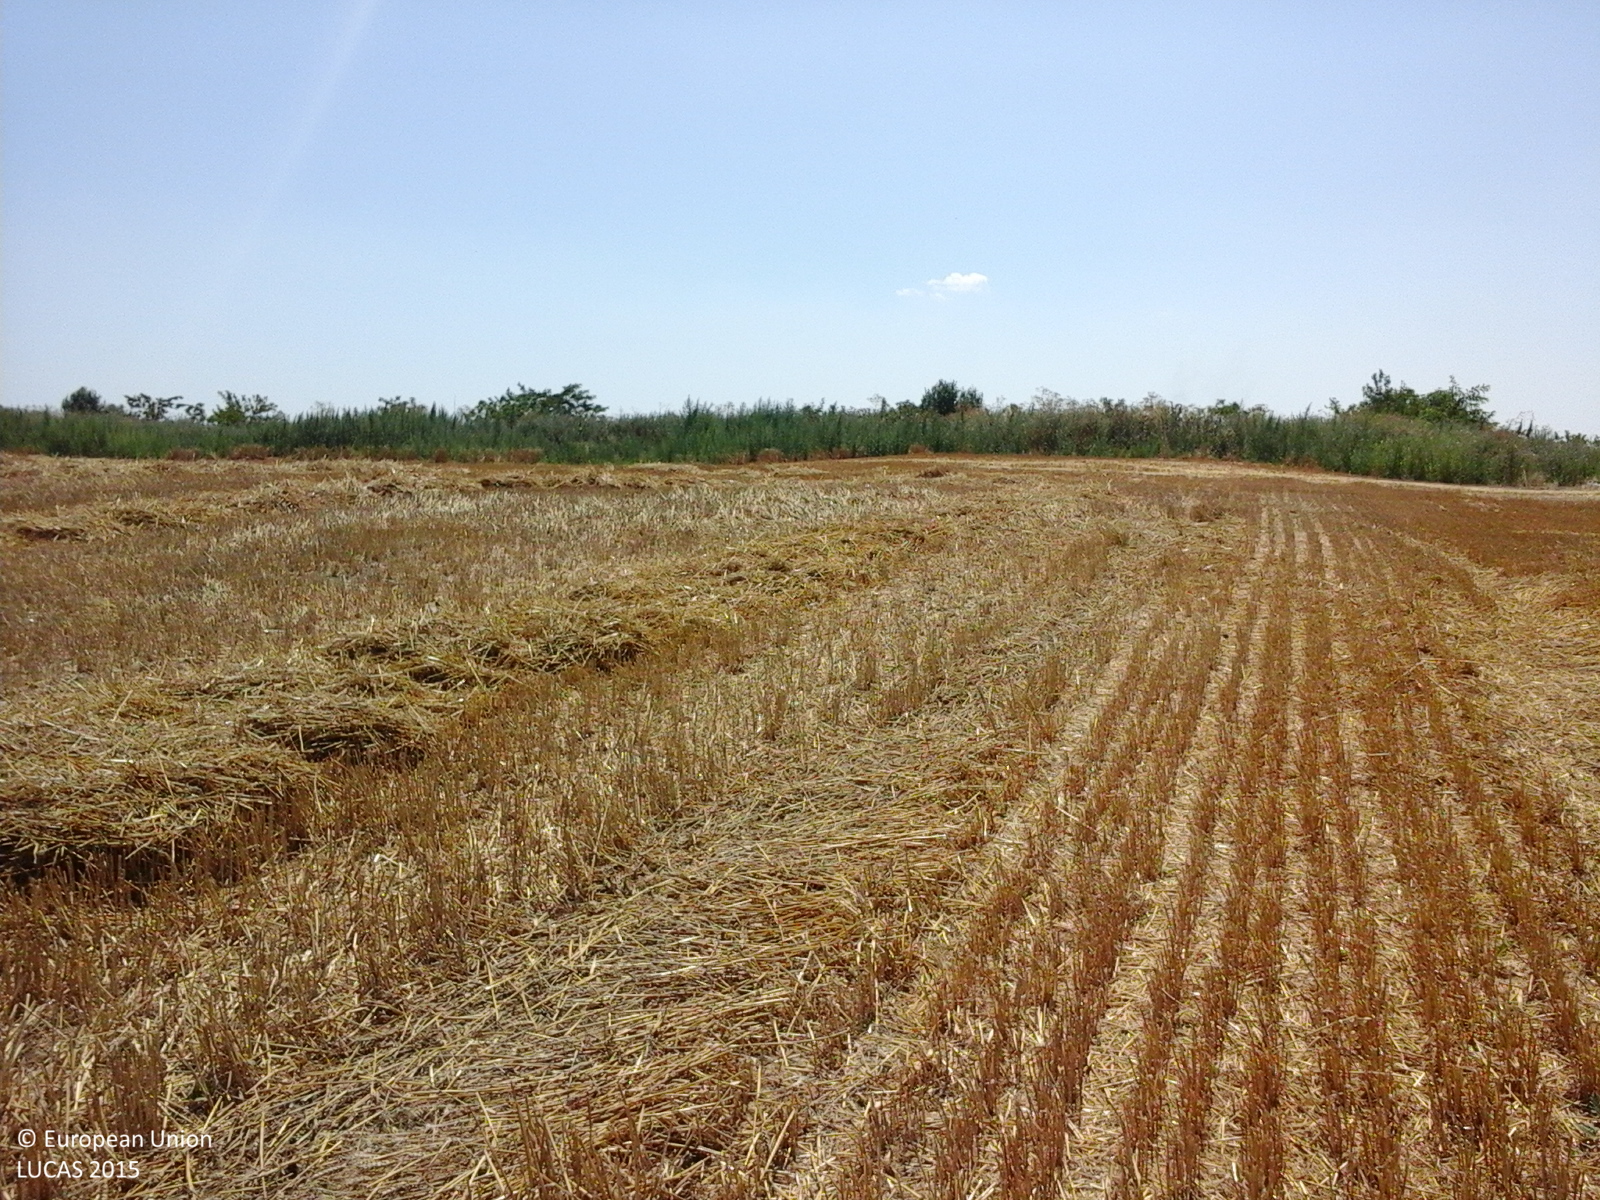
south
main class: Cropland
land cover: Common wheat
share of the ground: 50 - 75 %
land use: Agriculture (excluding fallow land and kitchen gardens)
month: July
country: RO
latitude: 44.2294
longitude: 26.9632
